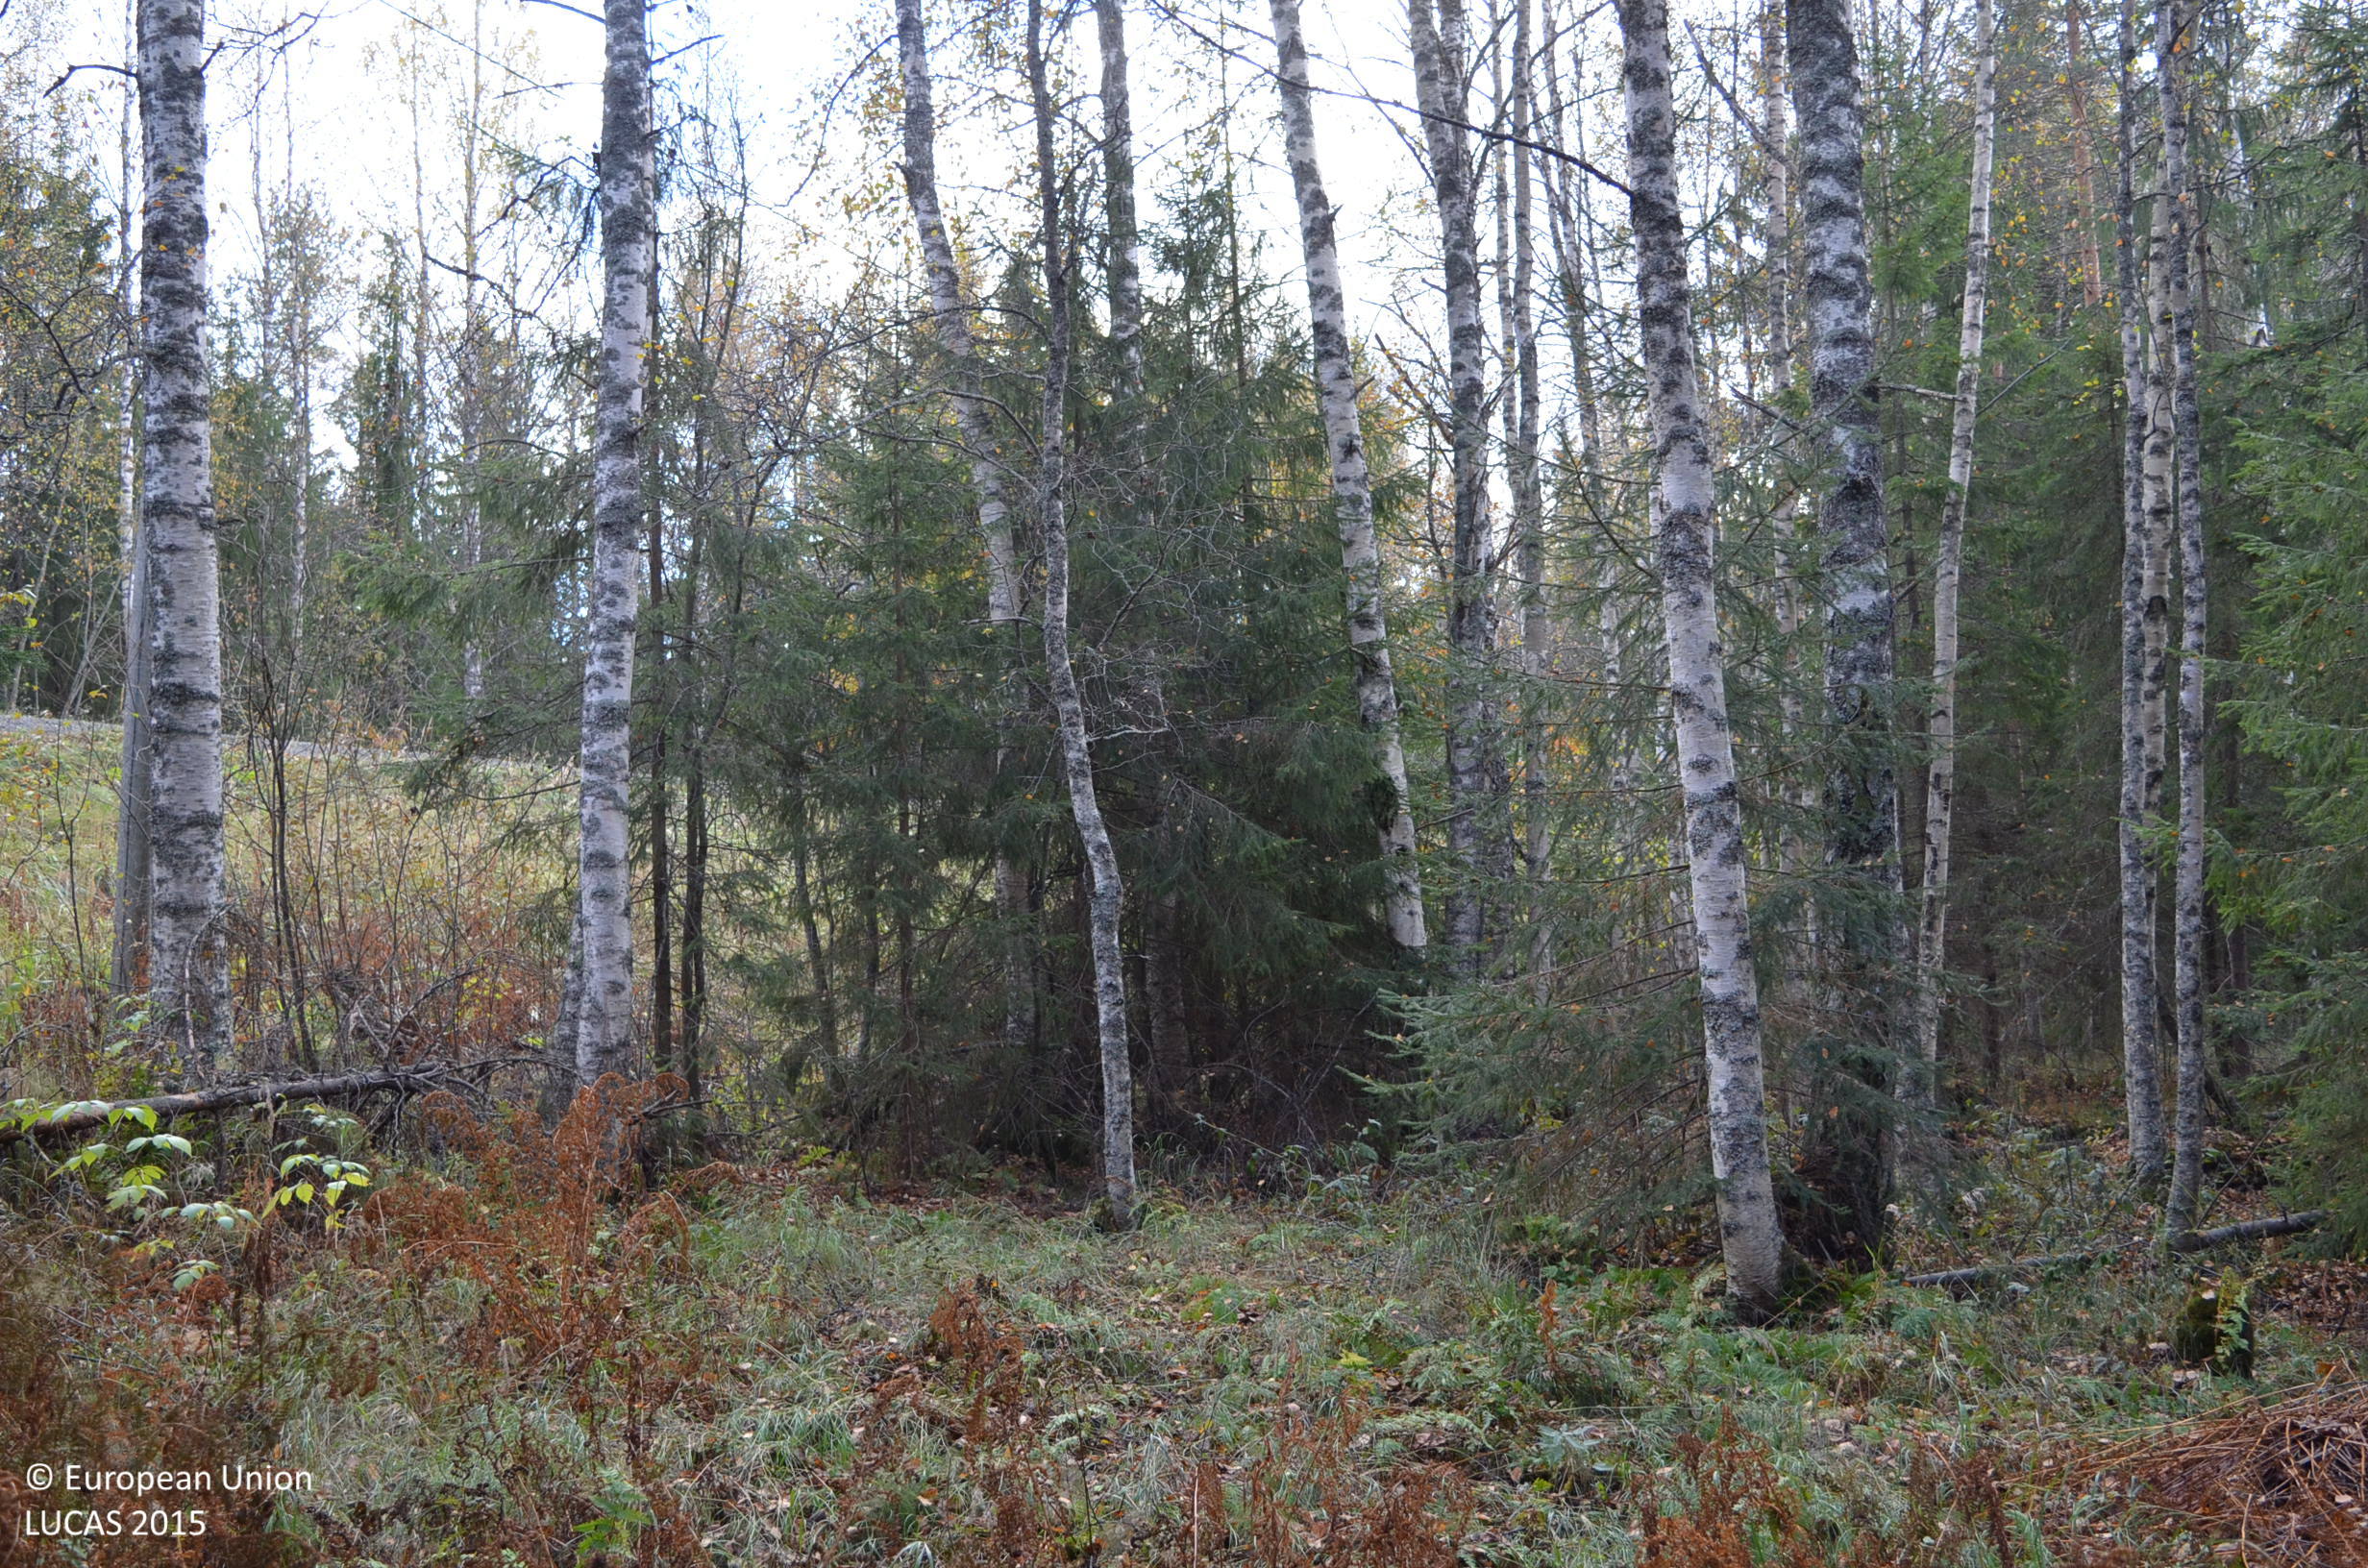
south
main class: Woodland
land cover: Spruce dominated mixed woodland
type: boreal forest
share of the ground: 50 - 75 %
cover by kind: coniferous forest trees 35 %, broadleaved forest trees 35 %, herbaceous plants 25 %, shrubs 5 %
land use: Forestry
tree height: > 5 m
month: October
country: FI
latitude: 61.6914
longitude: 23.8647
